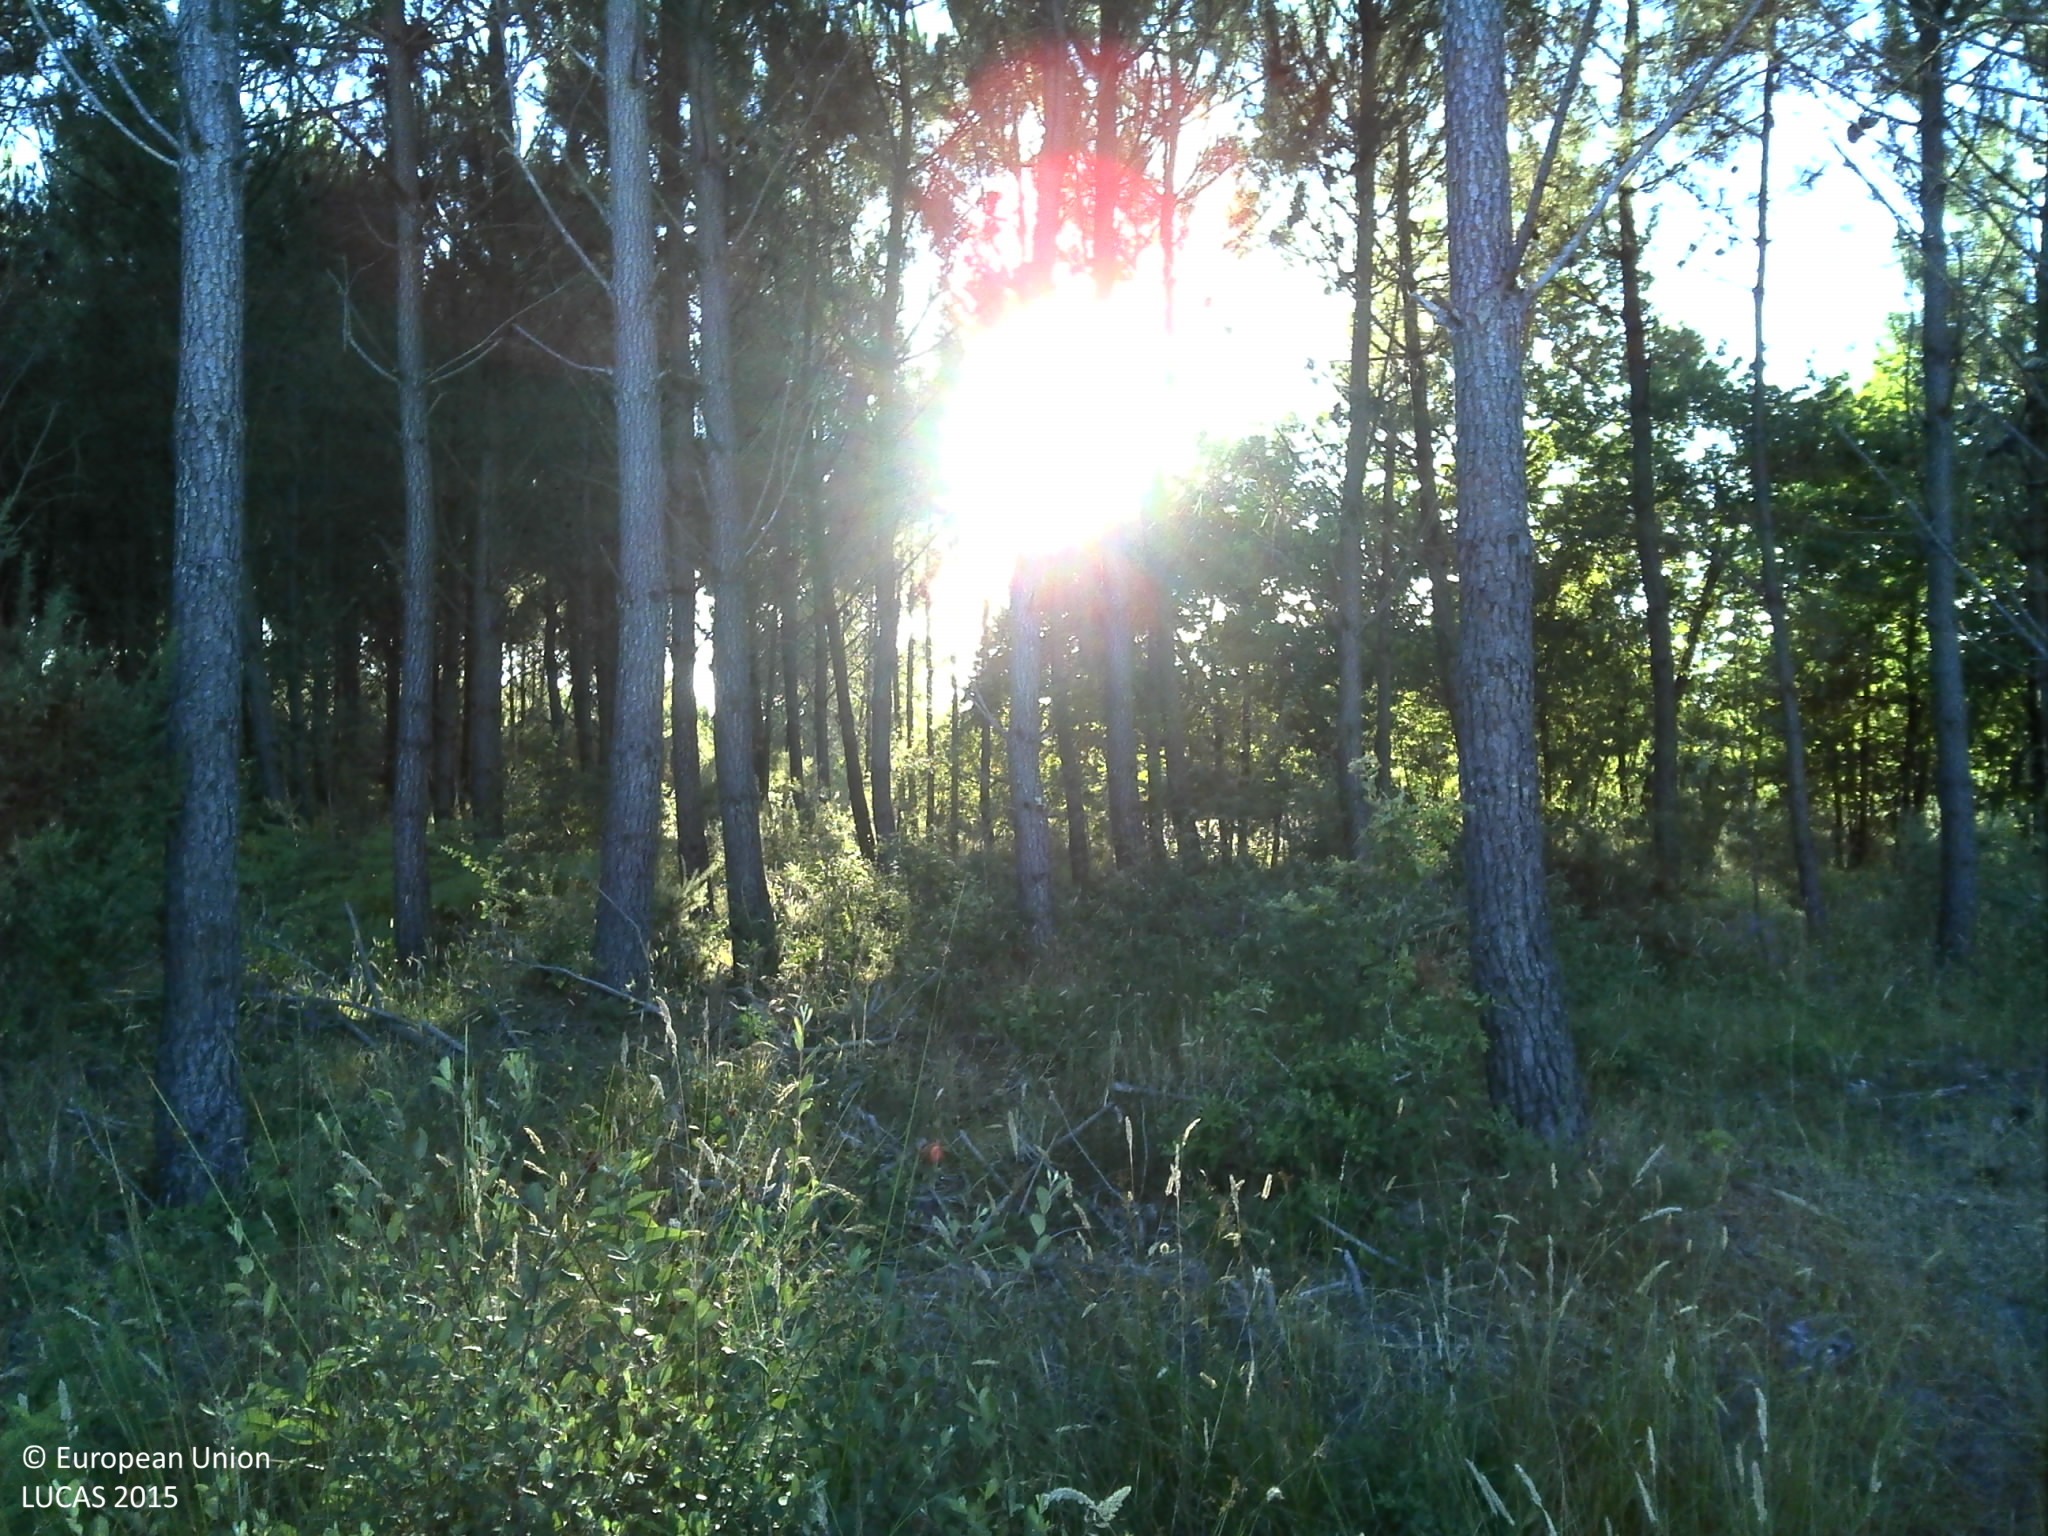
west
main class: Woodland
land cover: Pine dominated mixed woodland
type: exotic forest
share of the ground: > 75 %
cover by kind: coniferous forest trees 65 %, broadleaved forest trees 25 %, herbaceous plants 10 %
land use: Forestry
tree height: > 5 m
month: July
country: FR
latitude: 45.3391
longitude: -1.0650
